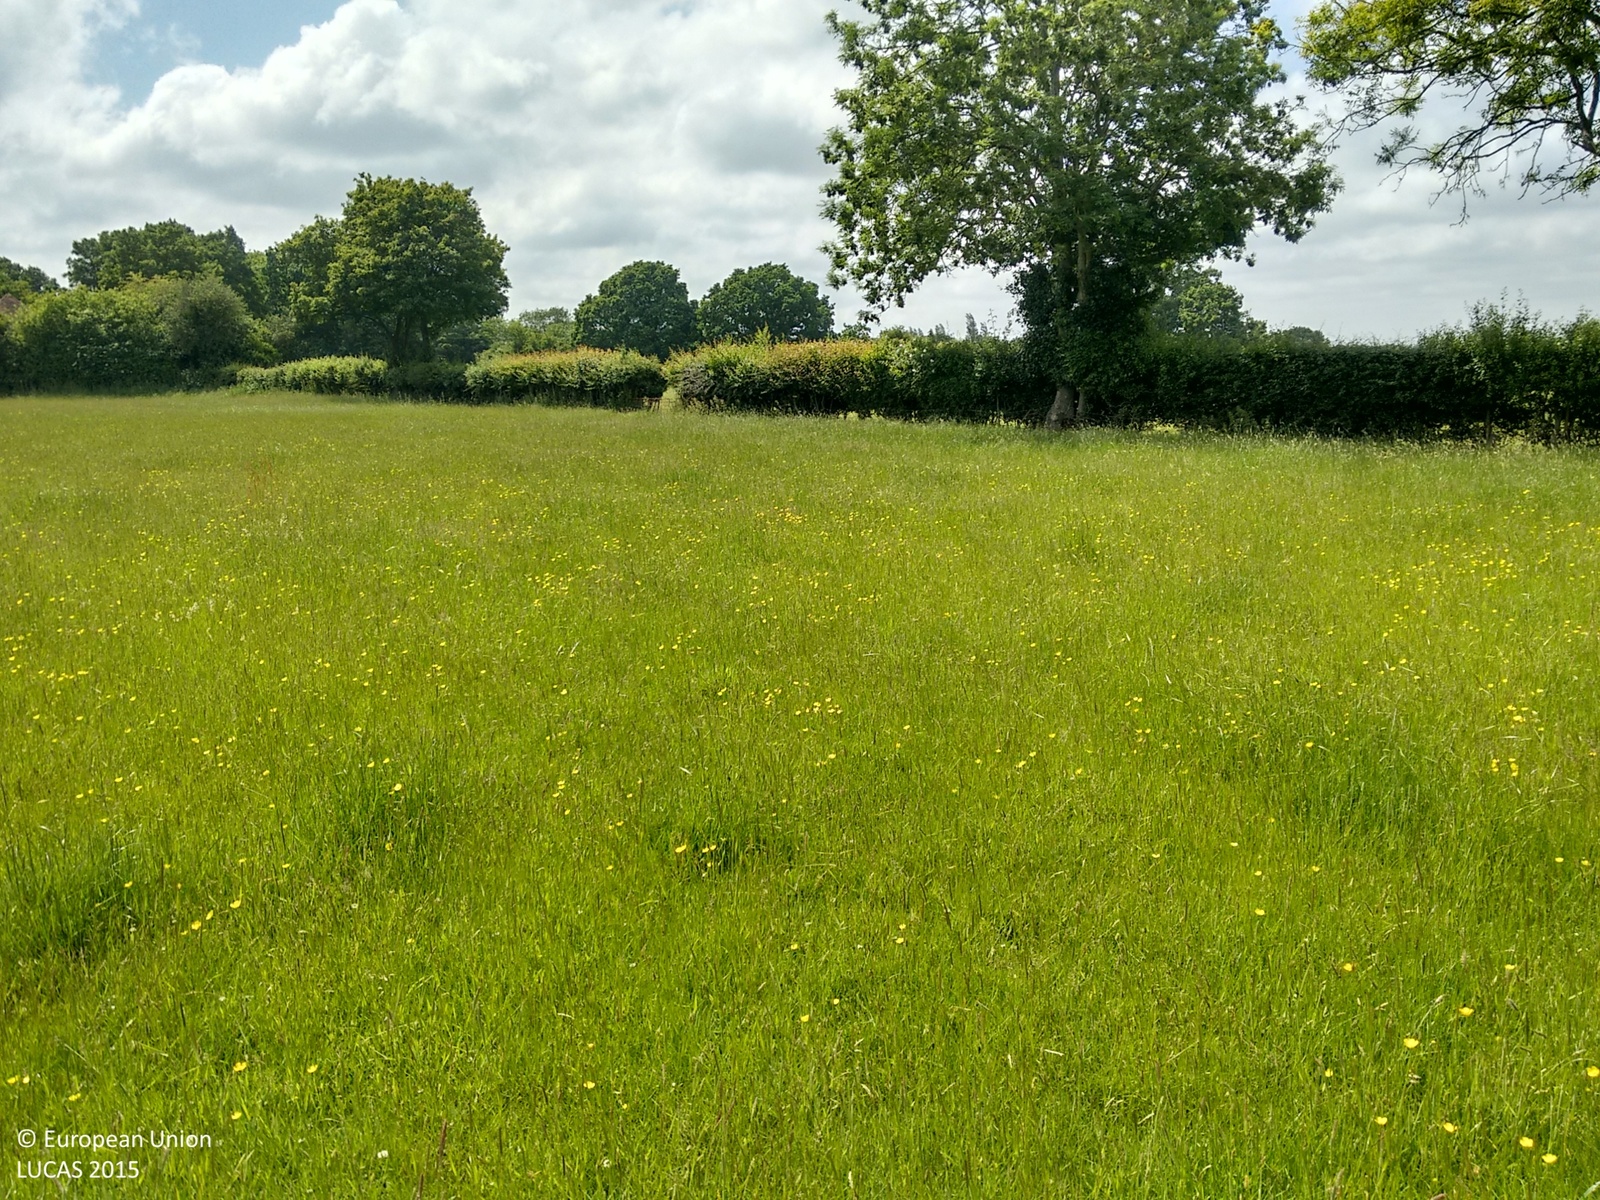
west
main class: Grassland
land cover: Grassland without tree/shrub cover
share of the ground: > 75 %
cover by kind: herbaceous plants 100 %
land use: Agriculture (excluding fallow land and kitchen gardens)
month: June
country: GB
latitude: 51.1180
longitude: 0.6158
